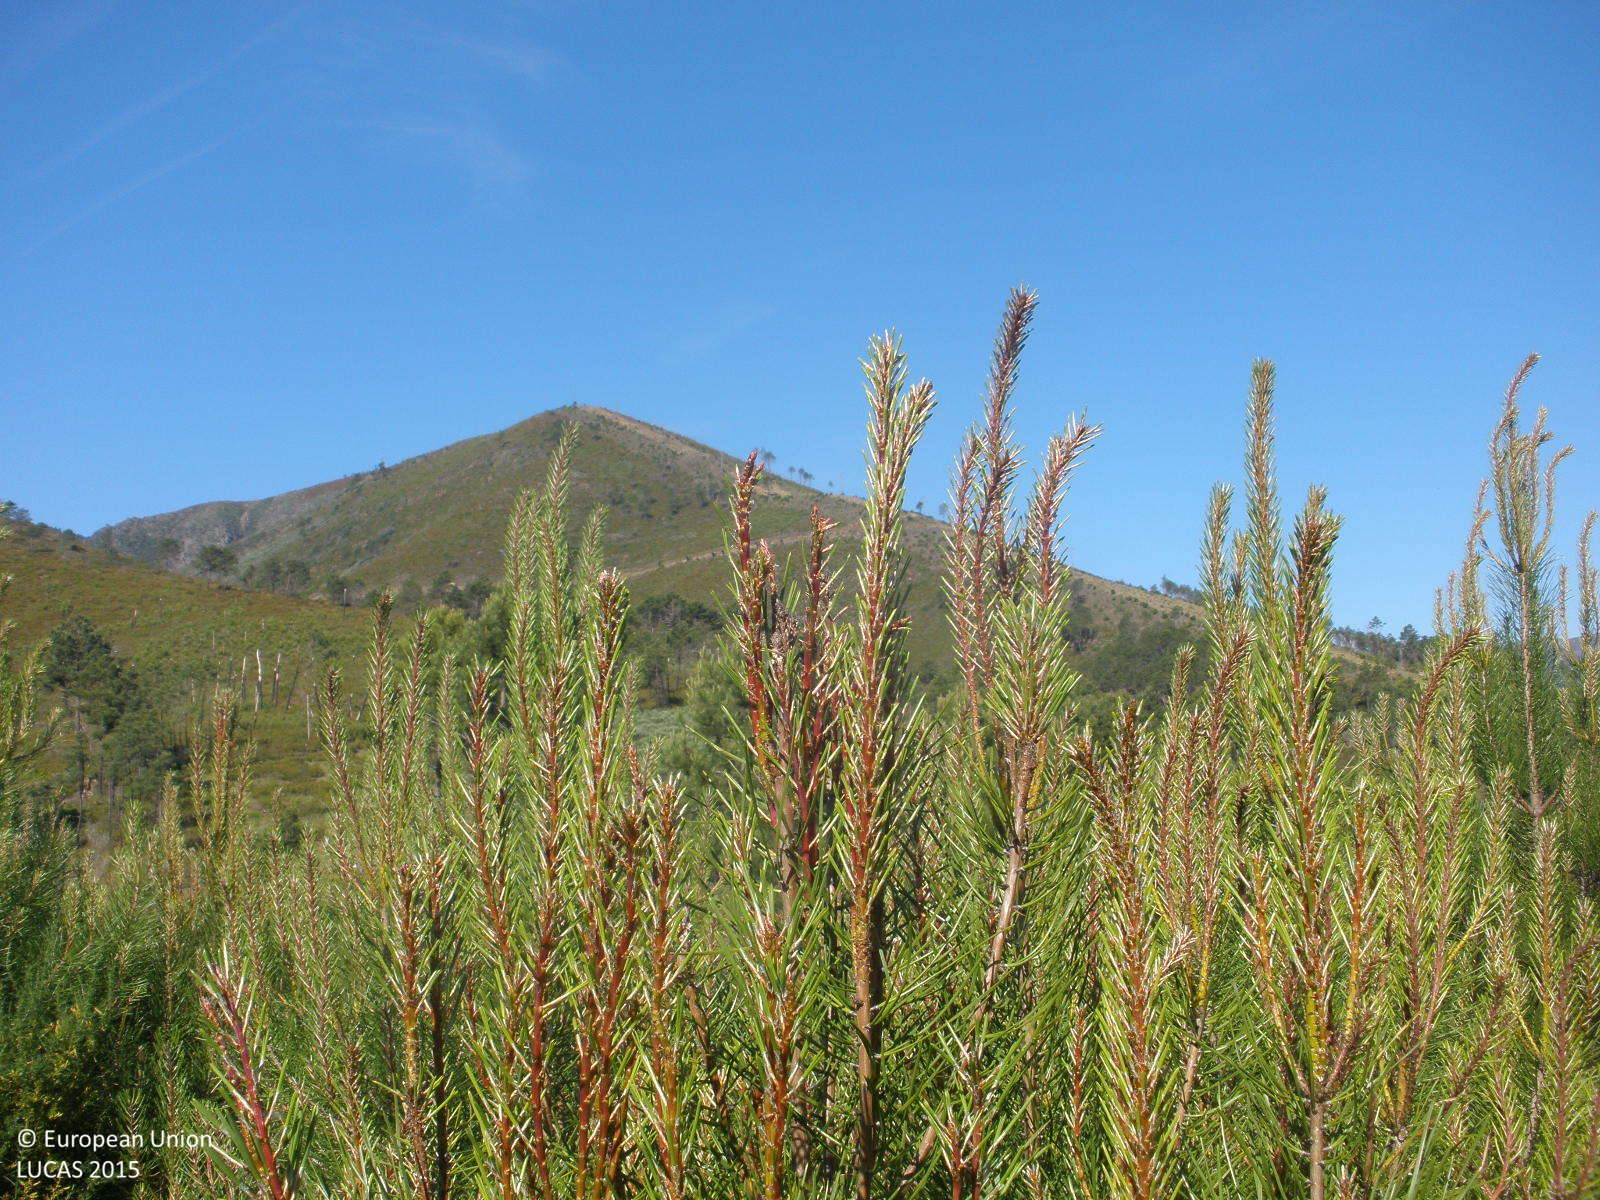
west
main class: Woodland
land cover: Pine dominated coniferous woodland
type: coniferous forest of the mediterranean region
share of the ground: > 75 %
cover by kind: coniferous forest trees 70 %, shrubs 30 %
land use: Forestry
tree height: < 5 m
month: May
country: ES
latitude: 40.4001
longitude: -6.2098
